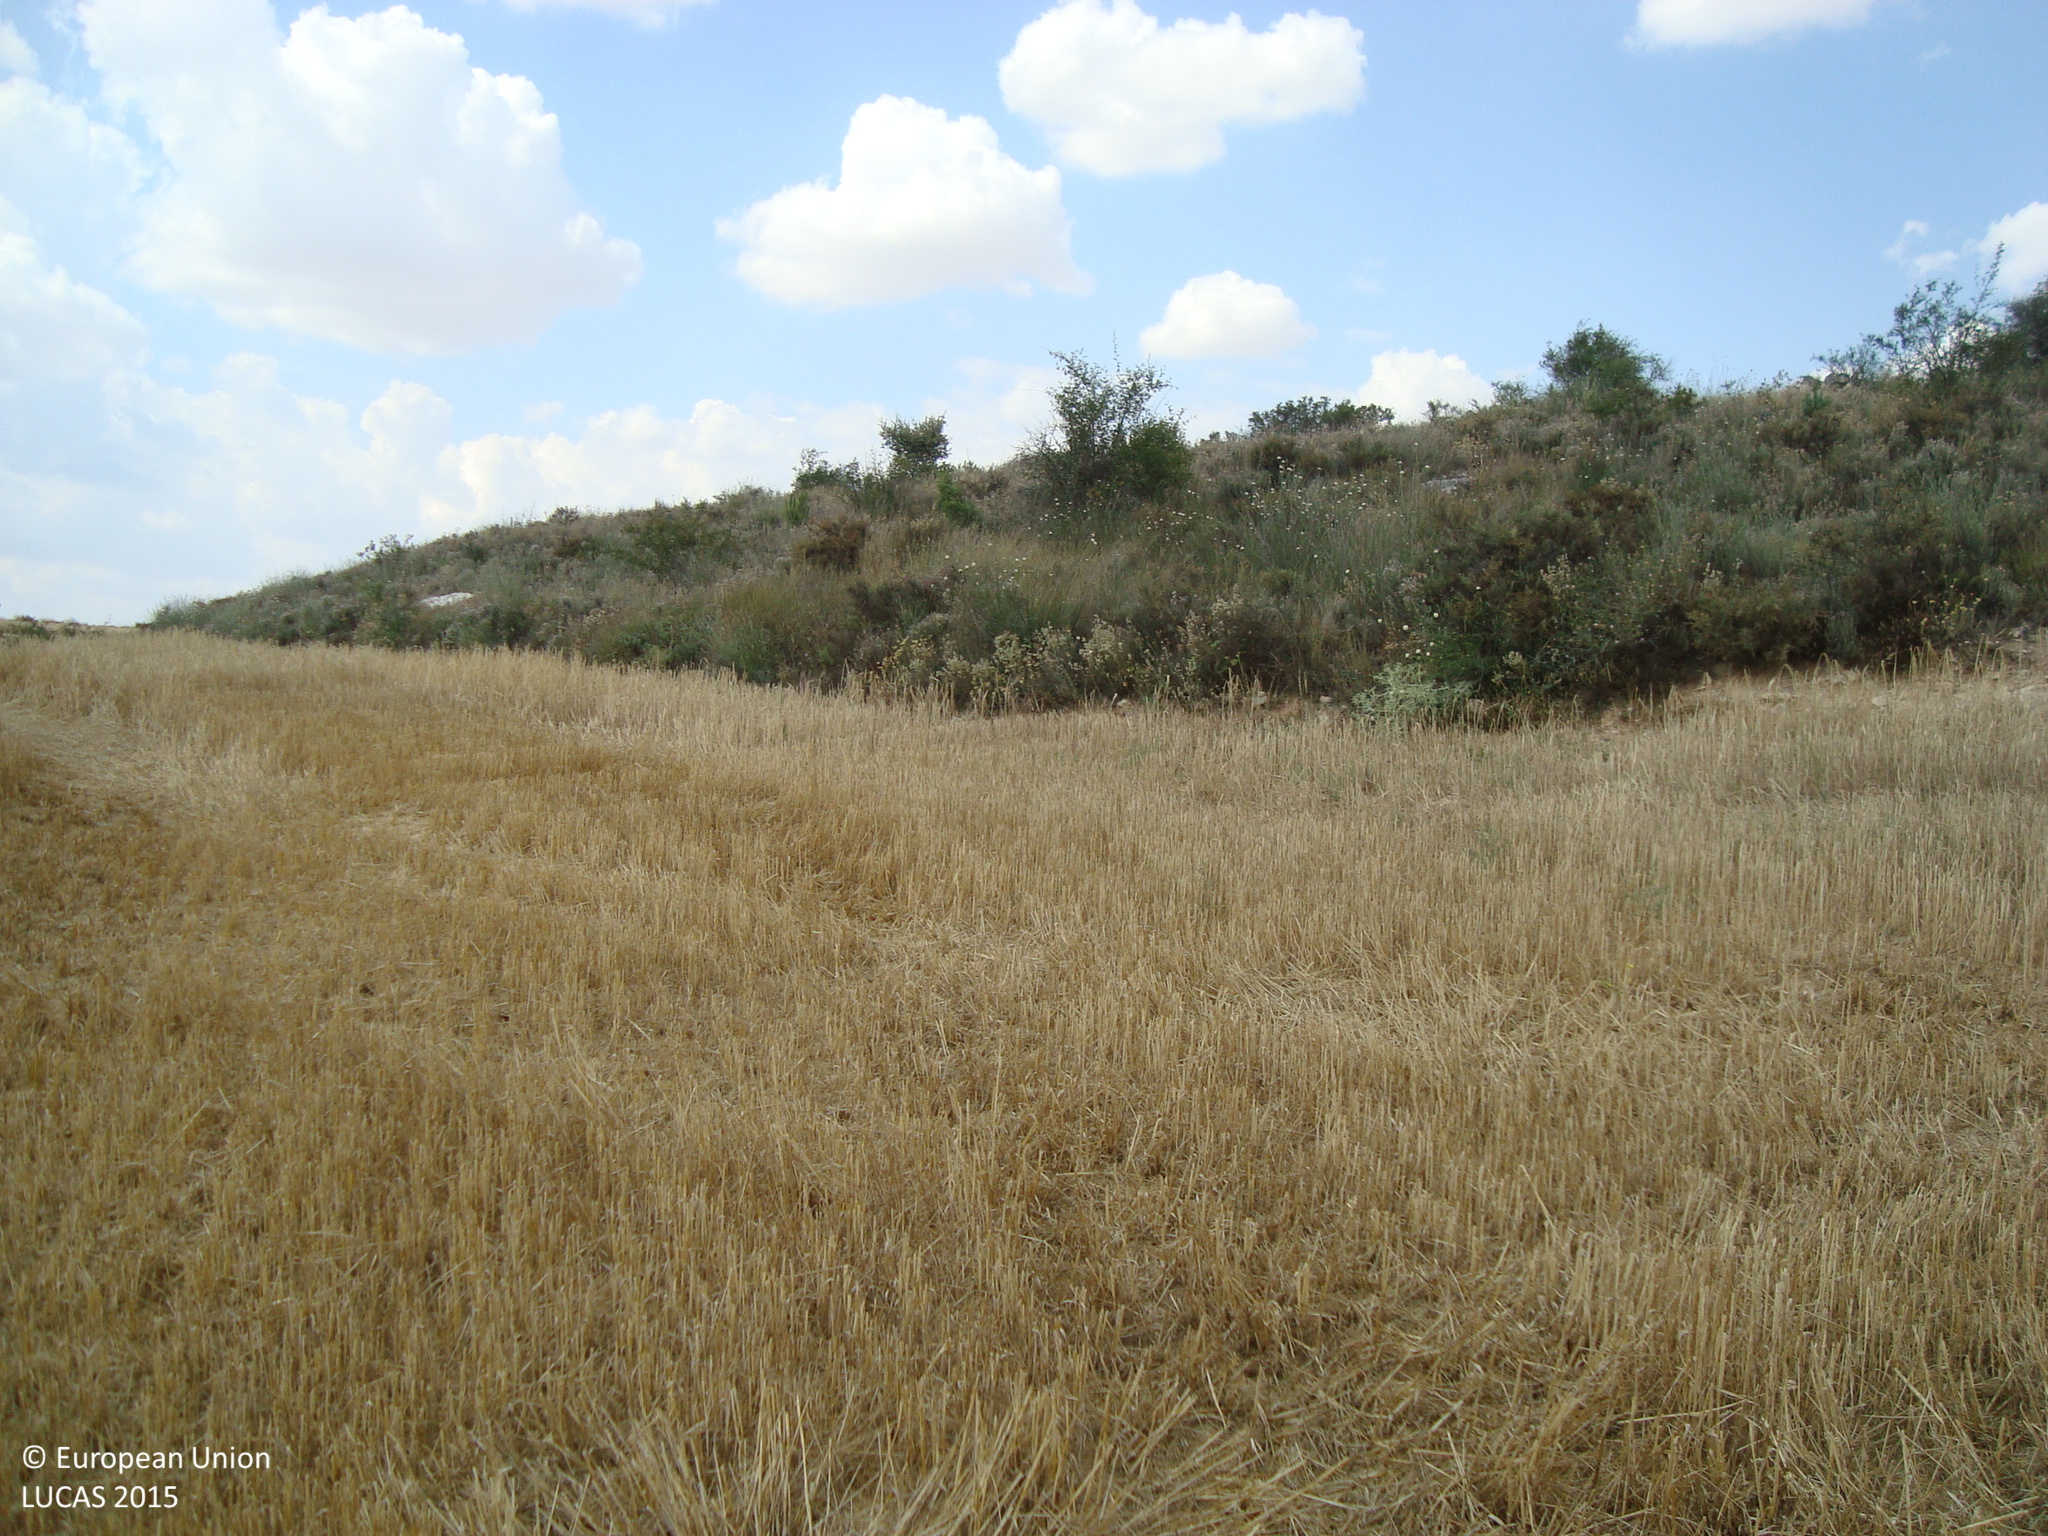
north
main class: Cropland
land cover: Barley
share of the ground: > 75 %
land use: Agriculture (excluding fallow land and kitchen gardens)
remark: Harvested field
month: July
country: ES
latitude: 41.9559
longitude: -4.0932
